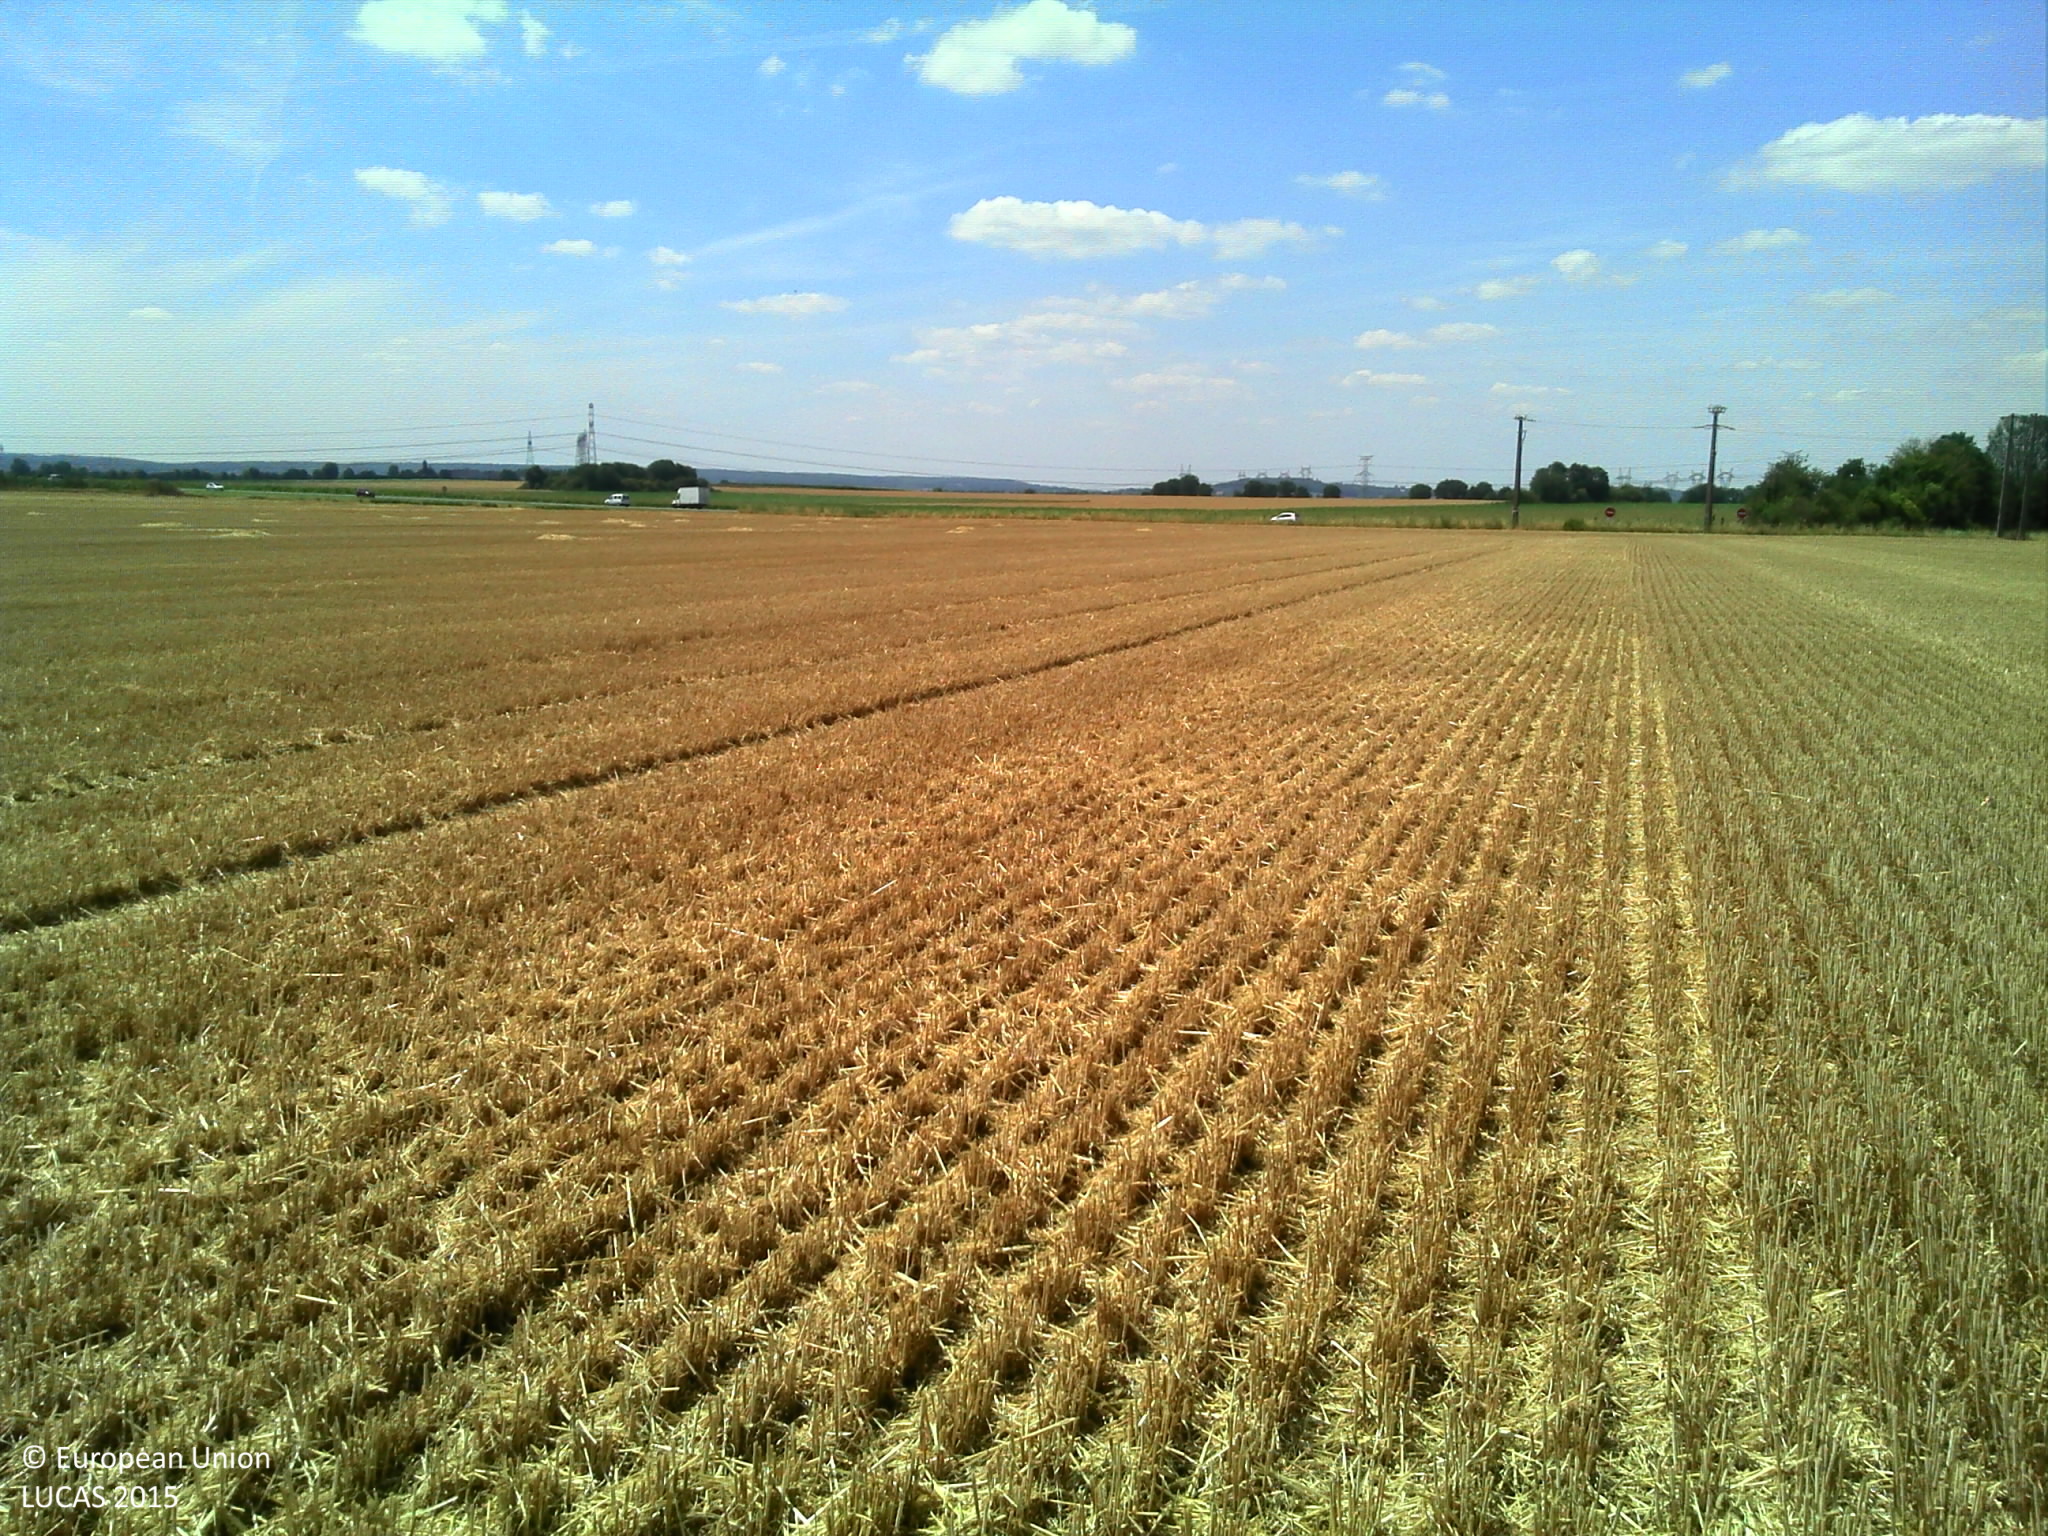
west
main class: Cropland
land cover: Common wheat
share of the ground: > 75 %
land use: Agriculture (excluding fallow land and kitchen gardens)
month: July
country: FR
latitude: 49.0825
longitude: 2.4166
